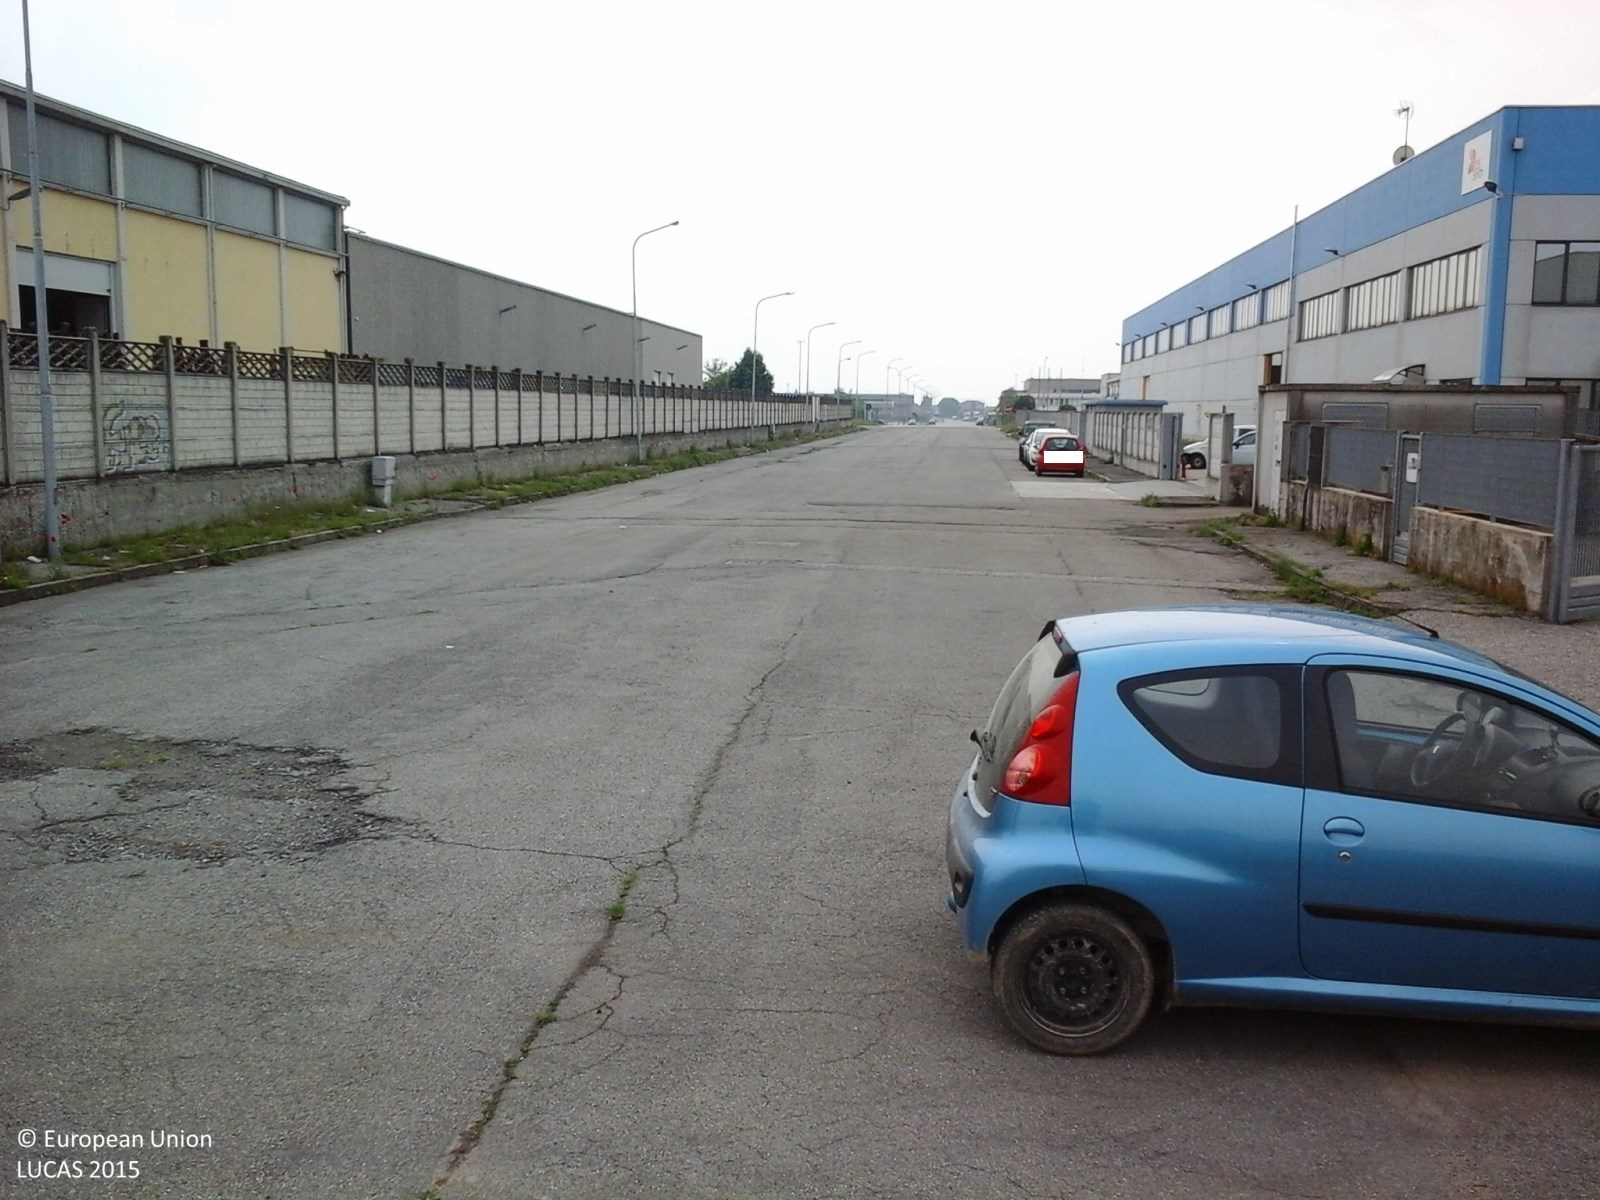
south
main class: Cropland
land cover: Common wheat
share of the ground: > 75 %
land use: Agriculture (excluding fallow land and kitchen gardens)
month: May
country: IT
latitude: 45.5309
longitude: 8.5810
